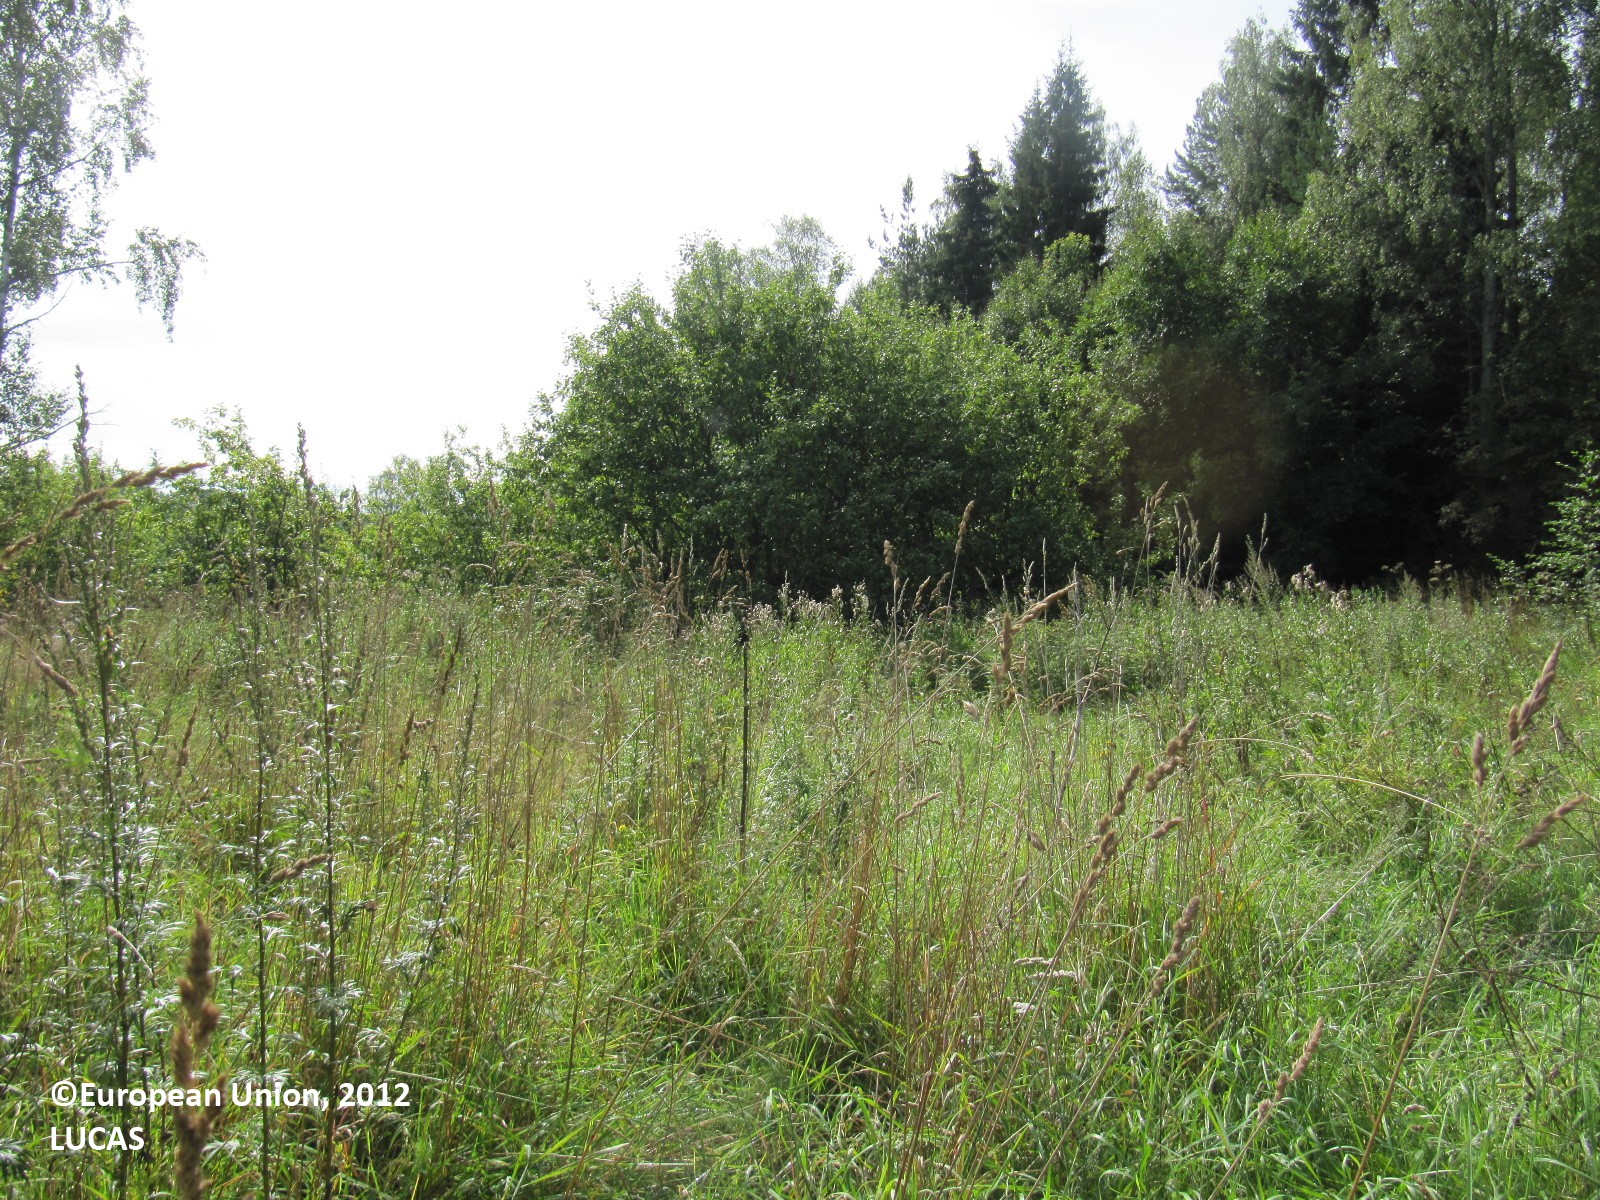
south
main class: Grassland
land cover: Spontaneously vegetated surfaces
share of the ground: > 75 %
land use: Fallow land
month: August
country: FI
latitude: 60.2237
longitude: 23.8693
